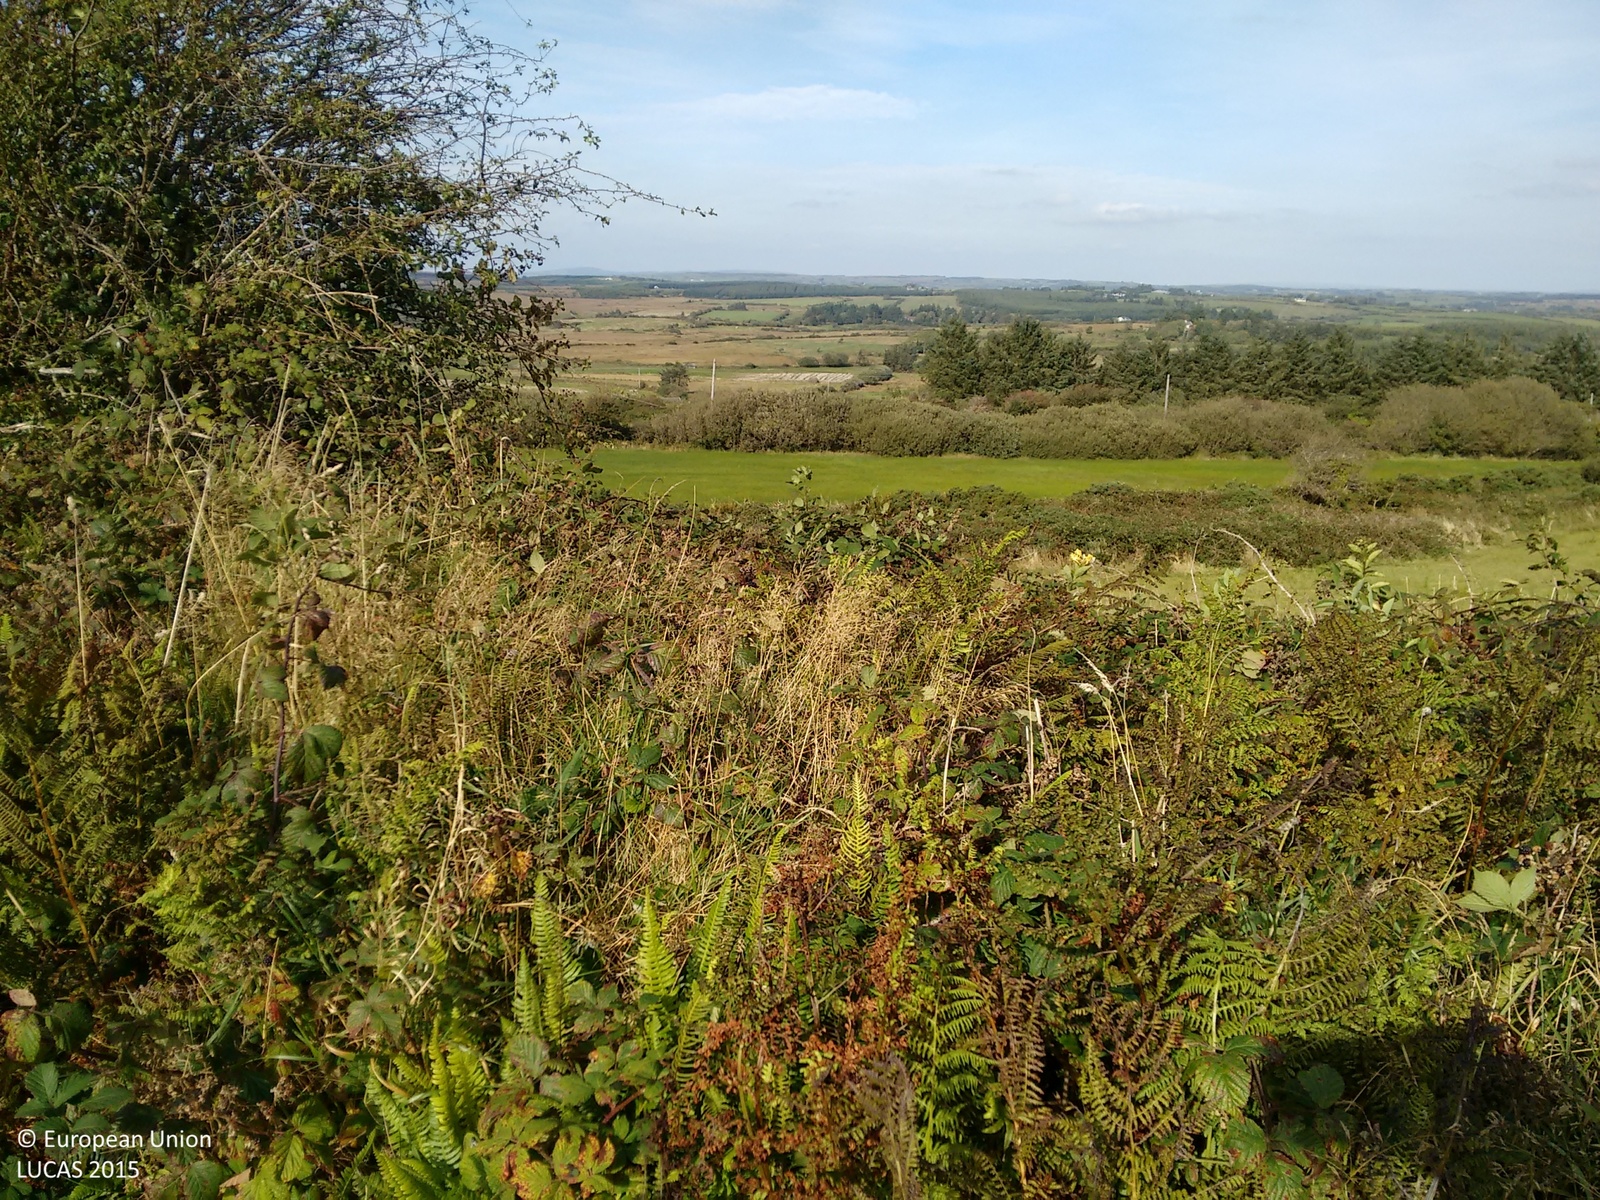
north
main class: Grassland
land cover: Grassland without tree/shrub cover
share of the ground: > 75 %
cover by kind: herbaceous plants 100 %
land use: Agriculture (excluding fallow land and kitchen gardens)
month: September
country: IE
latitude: 52.8714
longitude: -9.2541
